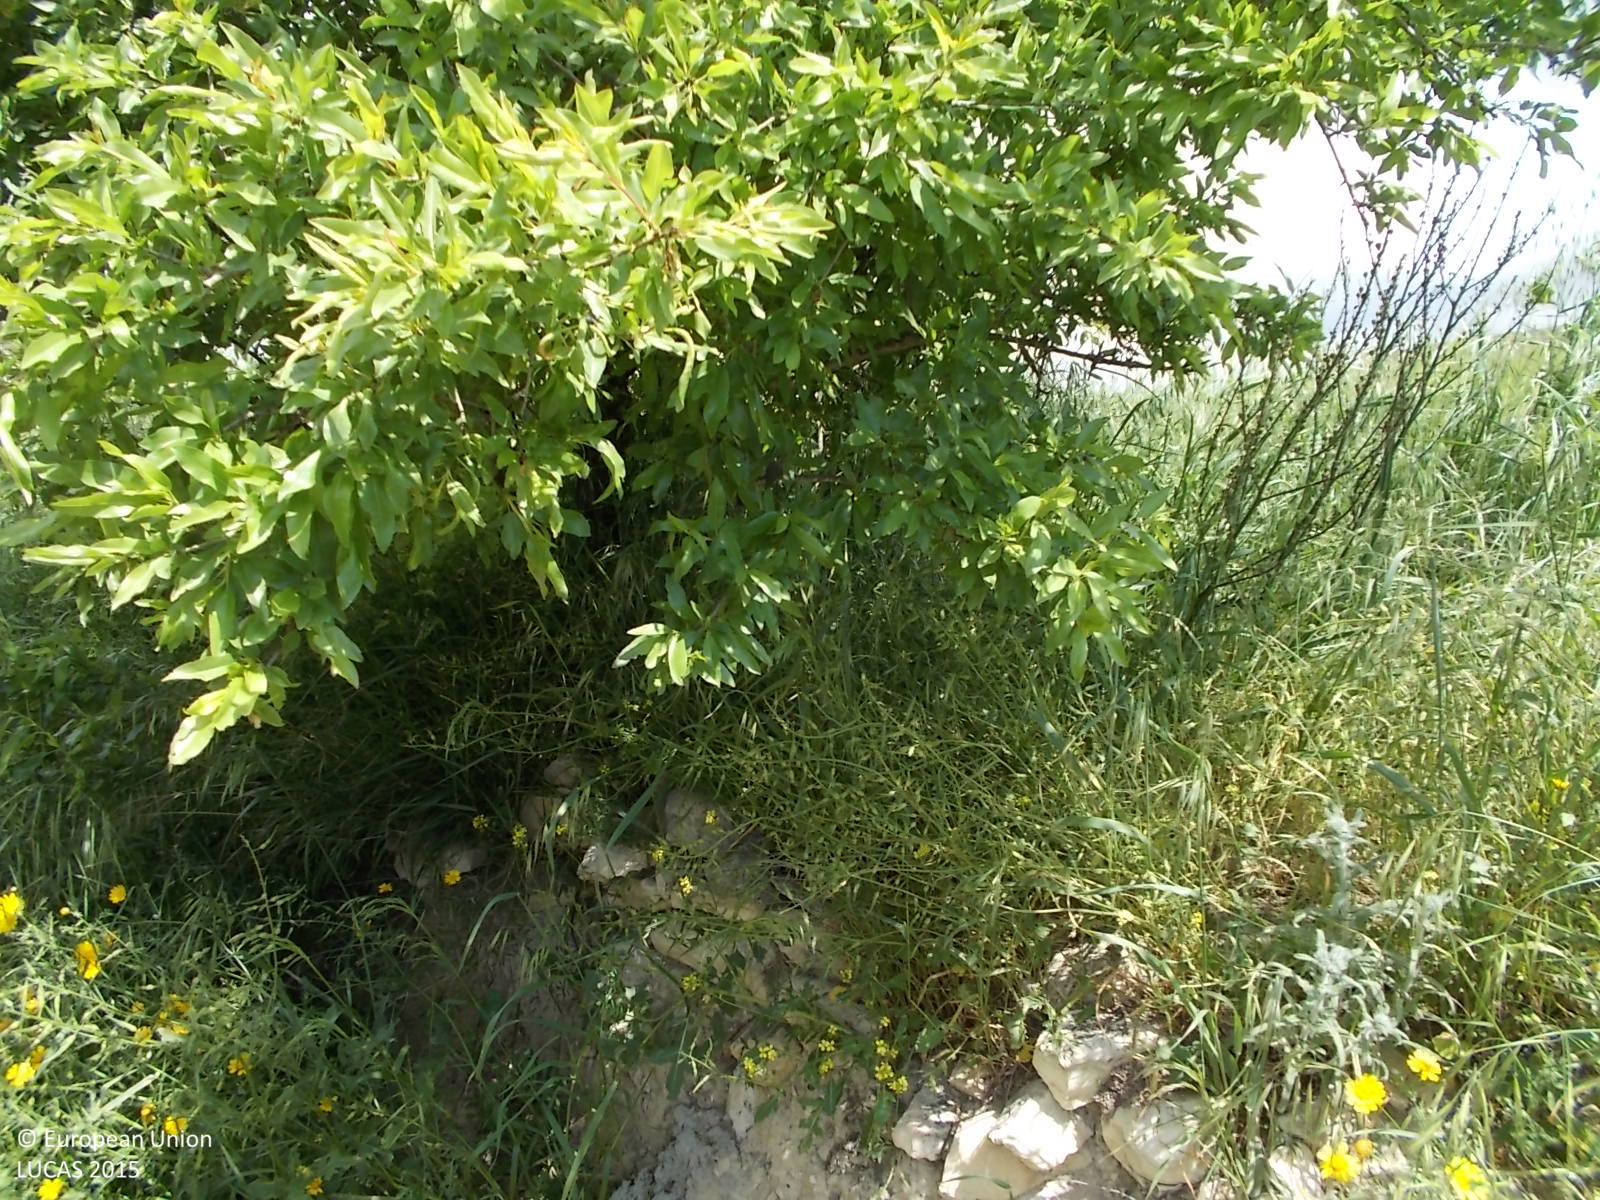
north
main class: Grassland
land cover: Grassland with sparse tree/shrub cover
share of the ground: > 75 %
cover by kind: herbaceous plants 80 %, unconsolidated bare surface 15 %, broadleaved forest trees 5 %
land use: Abandoned areas
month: April
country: CY
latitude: 35.0317
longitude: 33.5323
